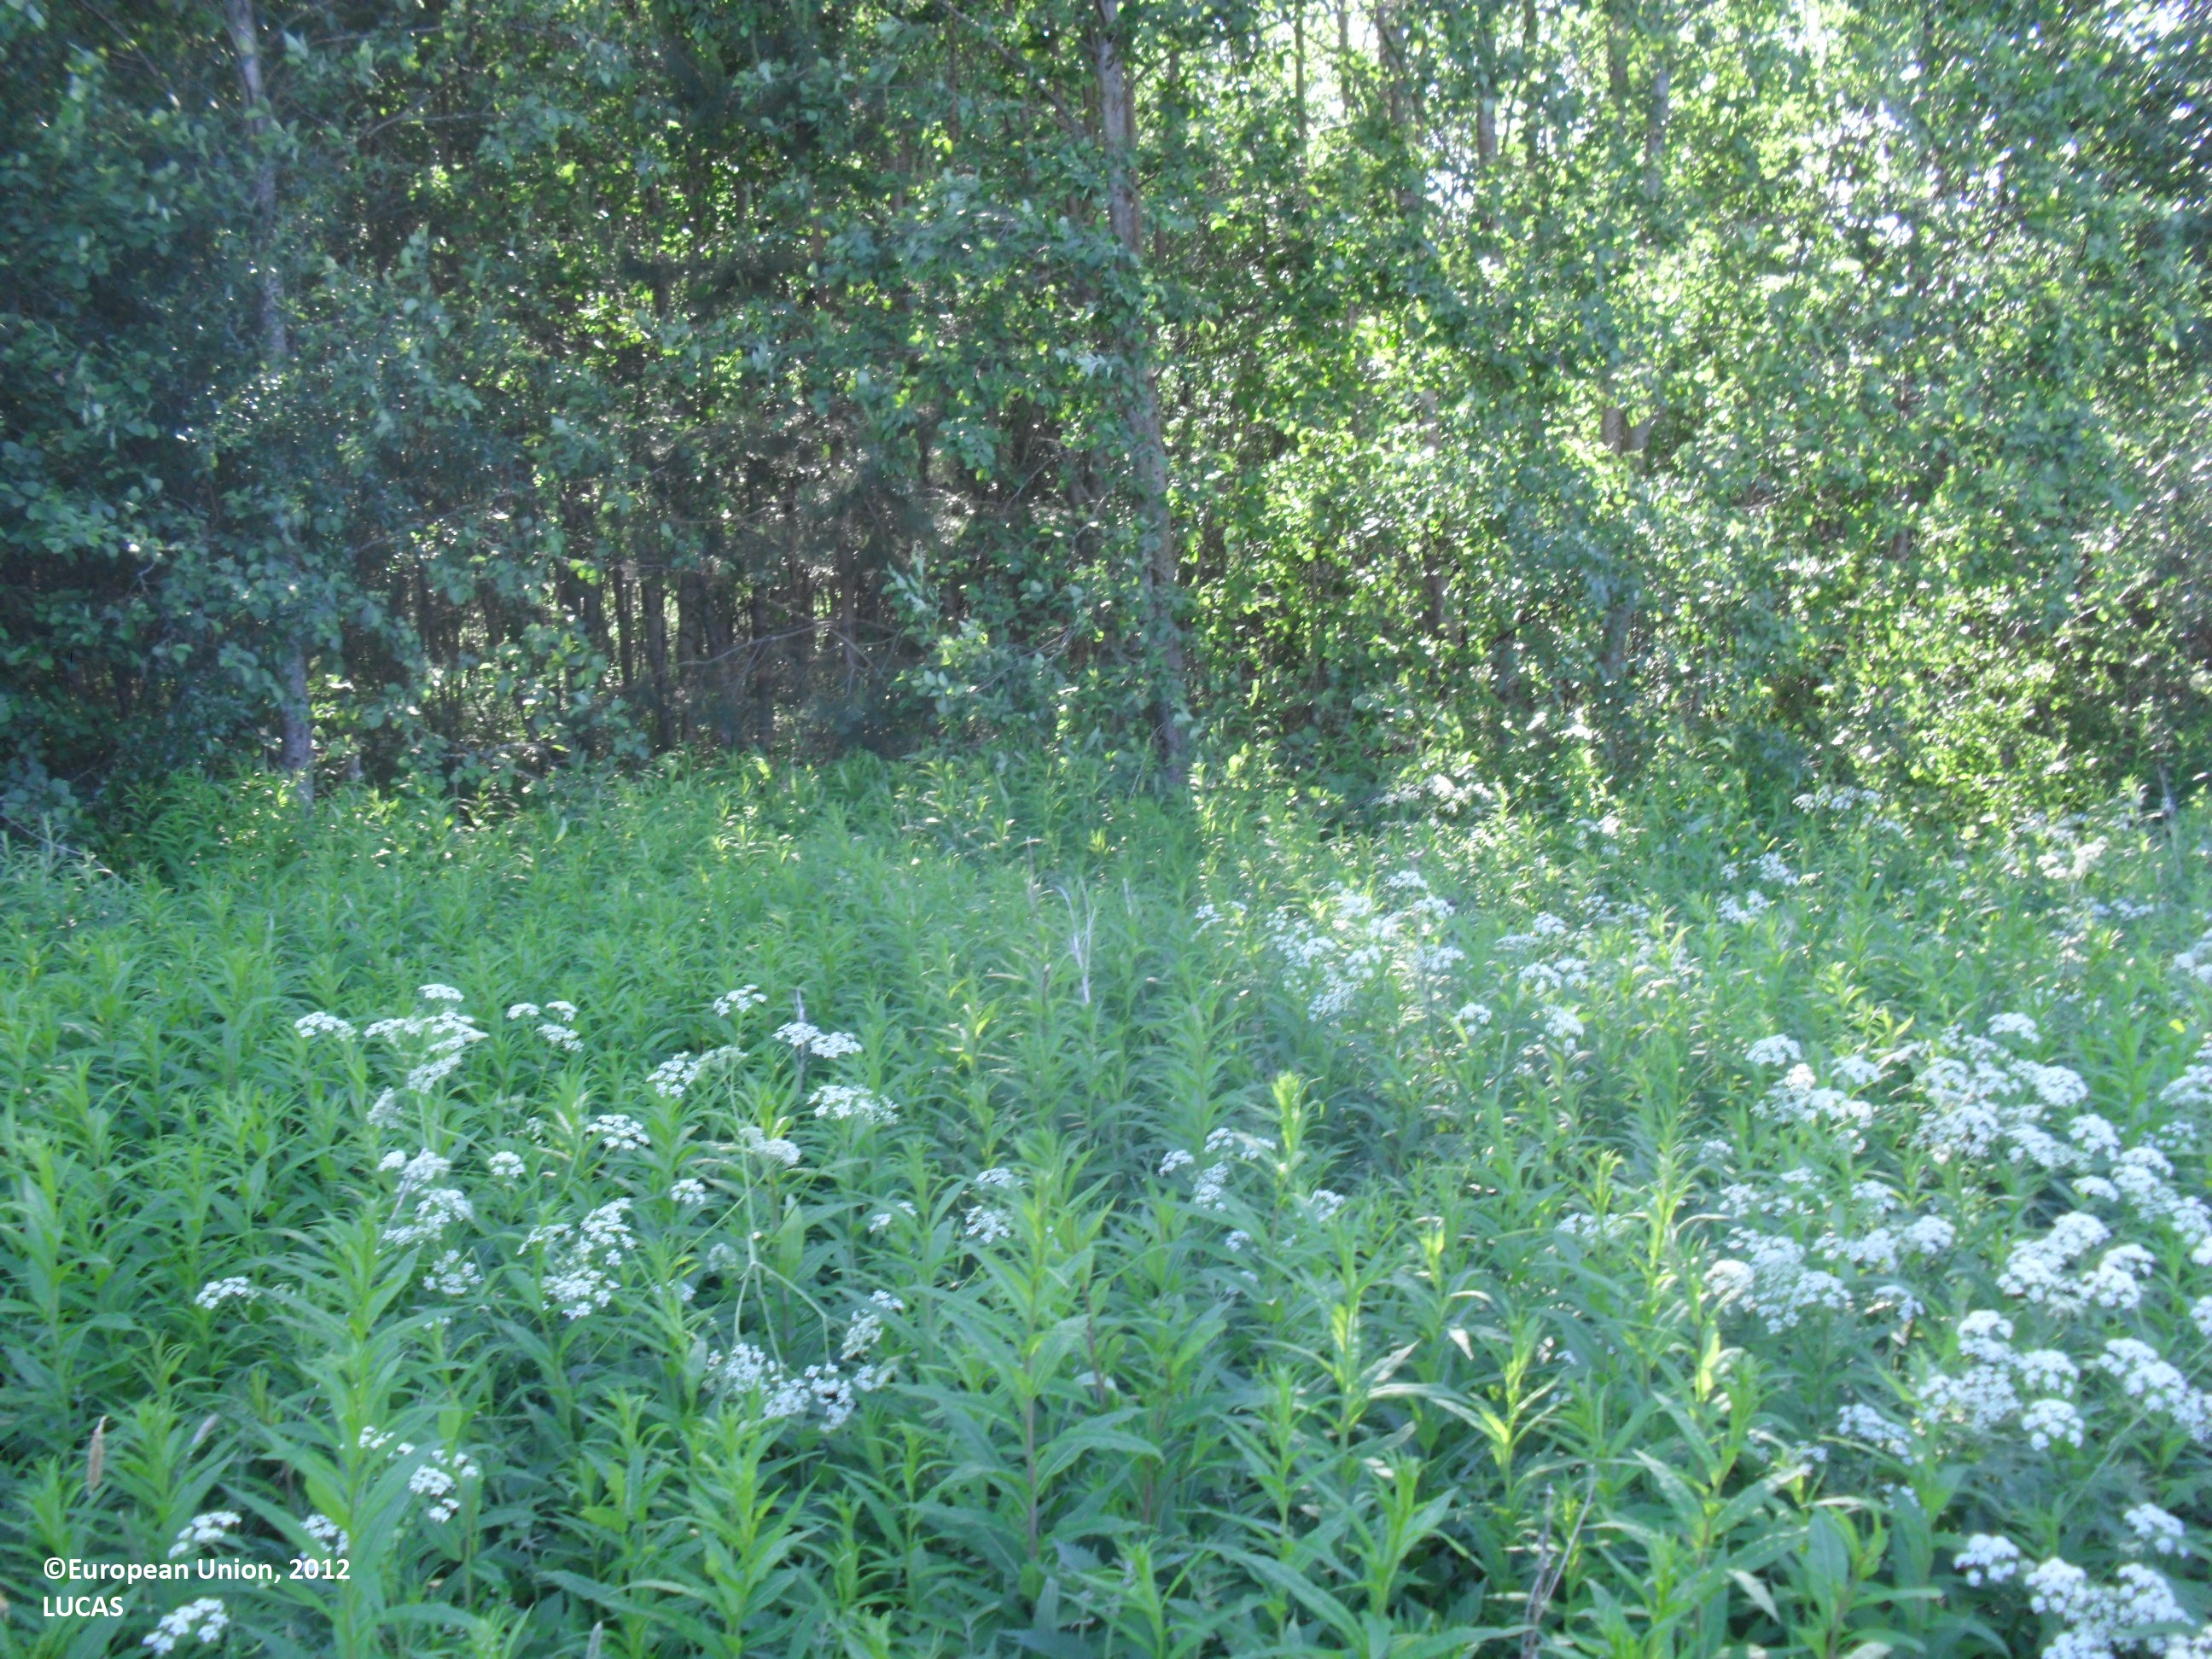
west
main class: Grassland
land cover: Spontaneously vegetated surfaces
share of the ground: > 75 %
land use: Abandoned areas
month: June
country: FI
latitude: 62.9876
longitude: 23.7475
